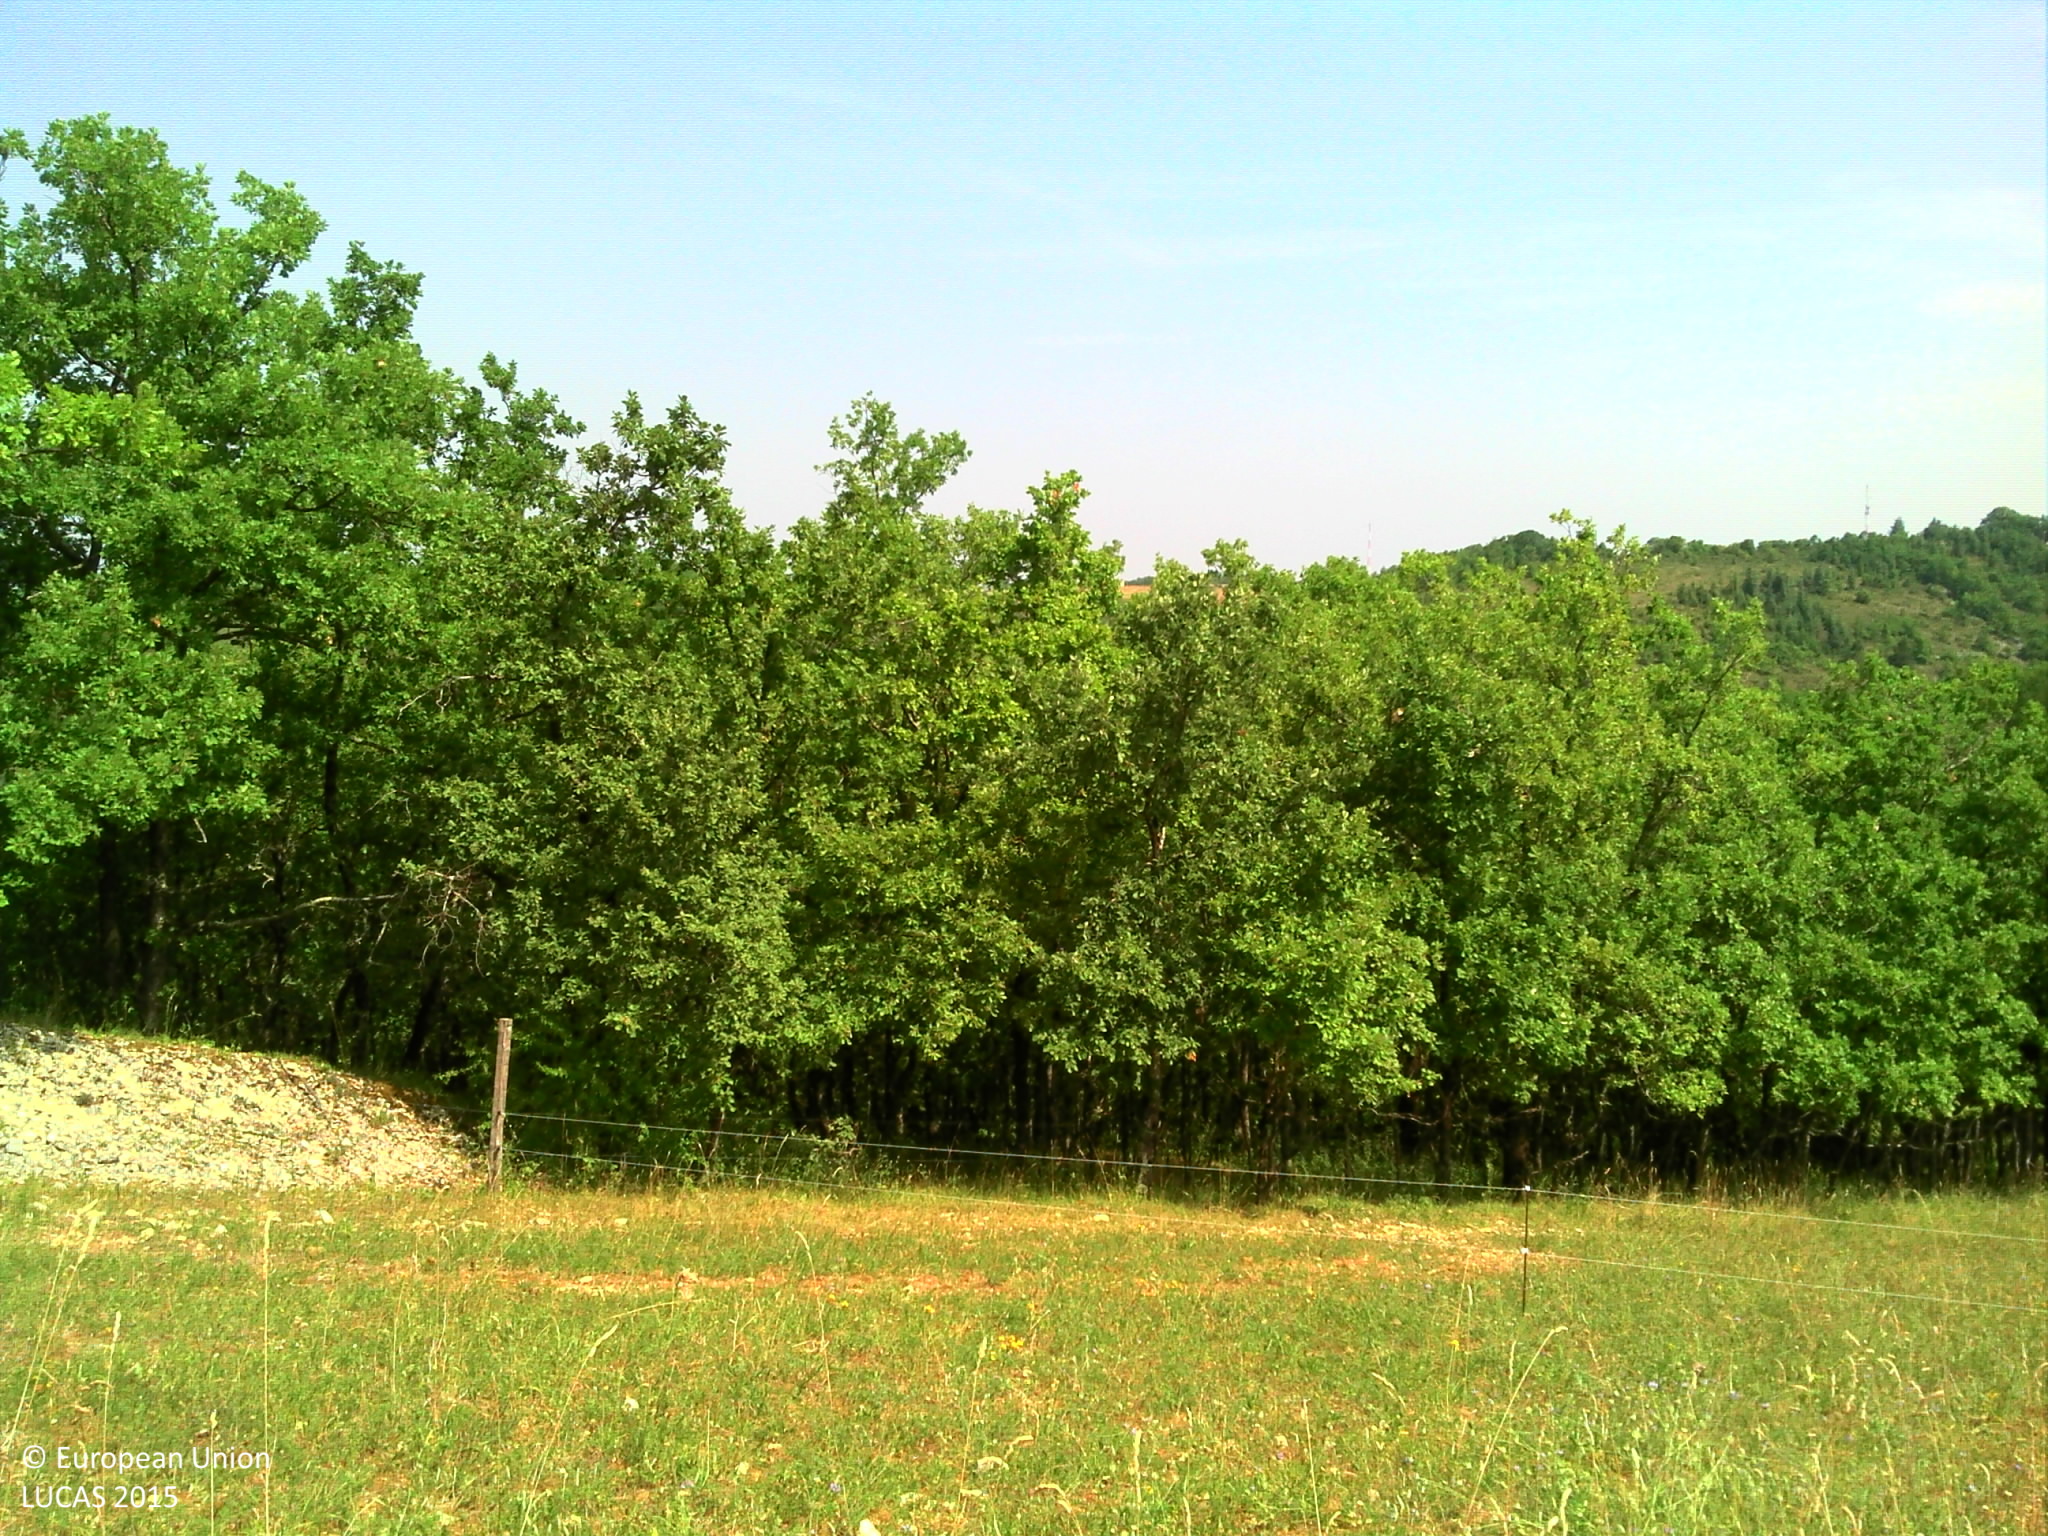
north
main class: Grassland
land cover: Grassland without tree/shrub cover
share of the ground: > 75 %
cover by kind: herbaceous plants 100 %
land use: Agriculture (excluding fallow land and kitchen gardens)
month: July
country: FR
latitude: 44.4495
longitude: 1.0110
